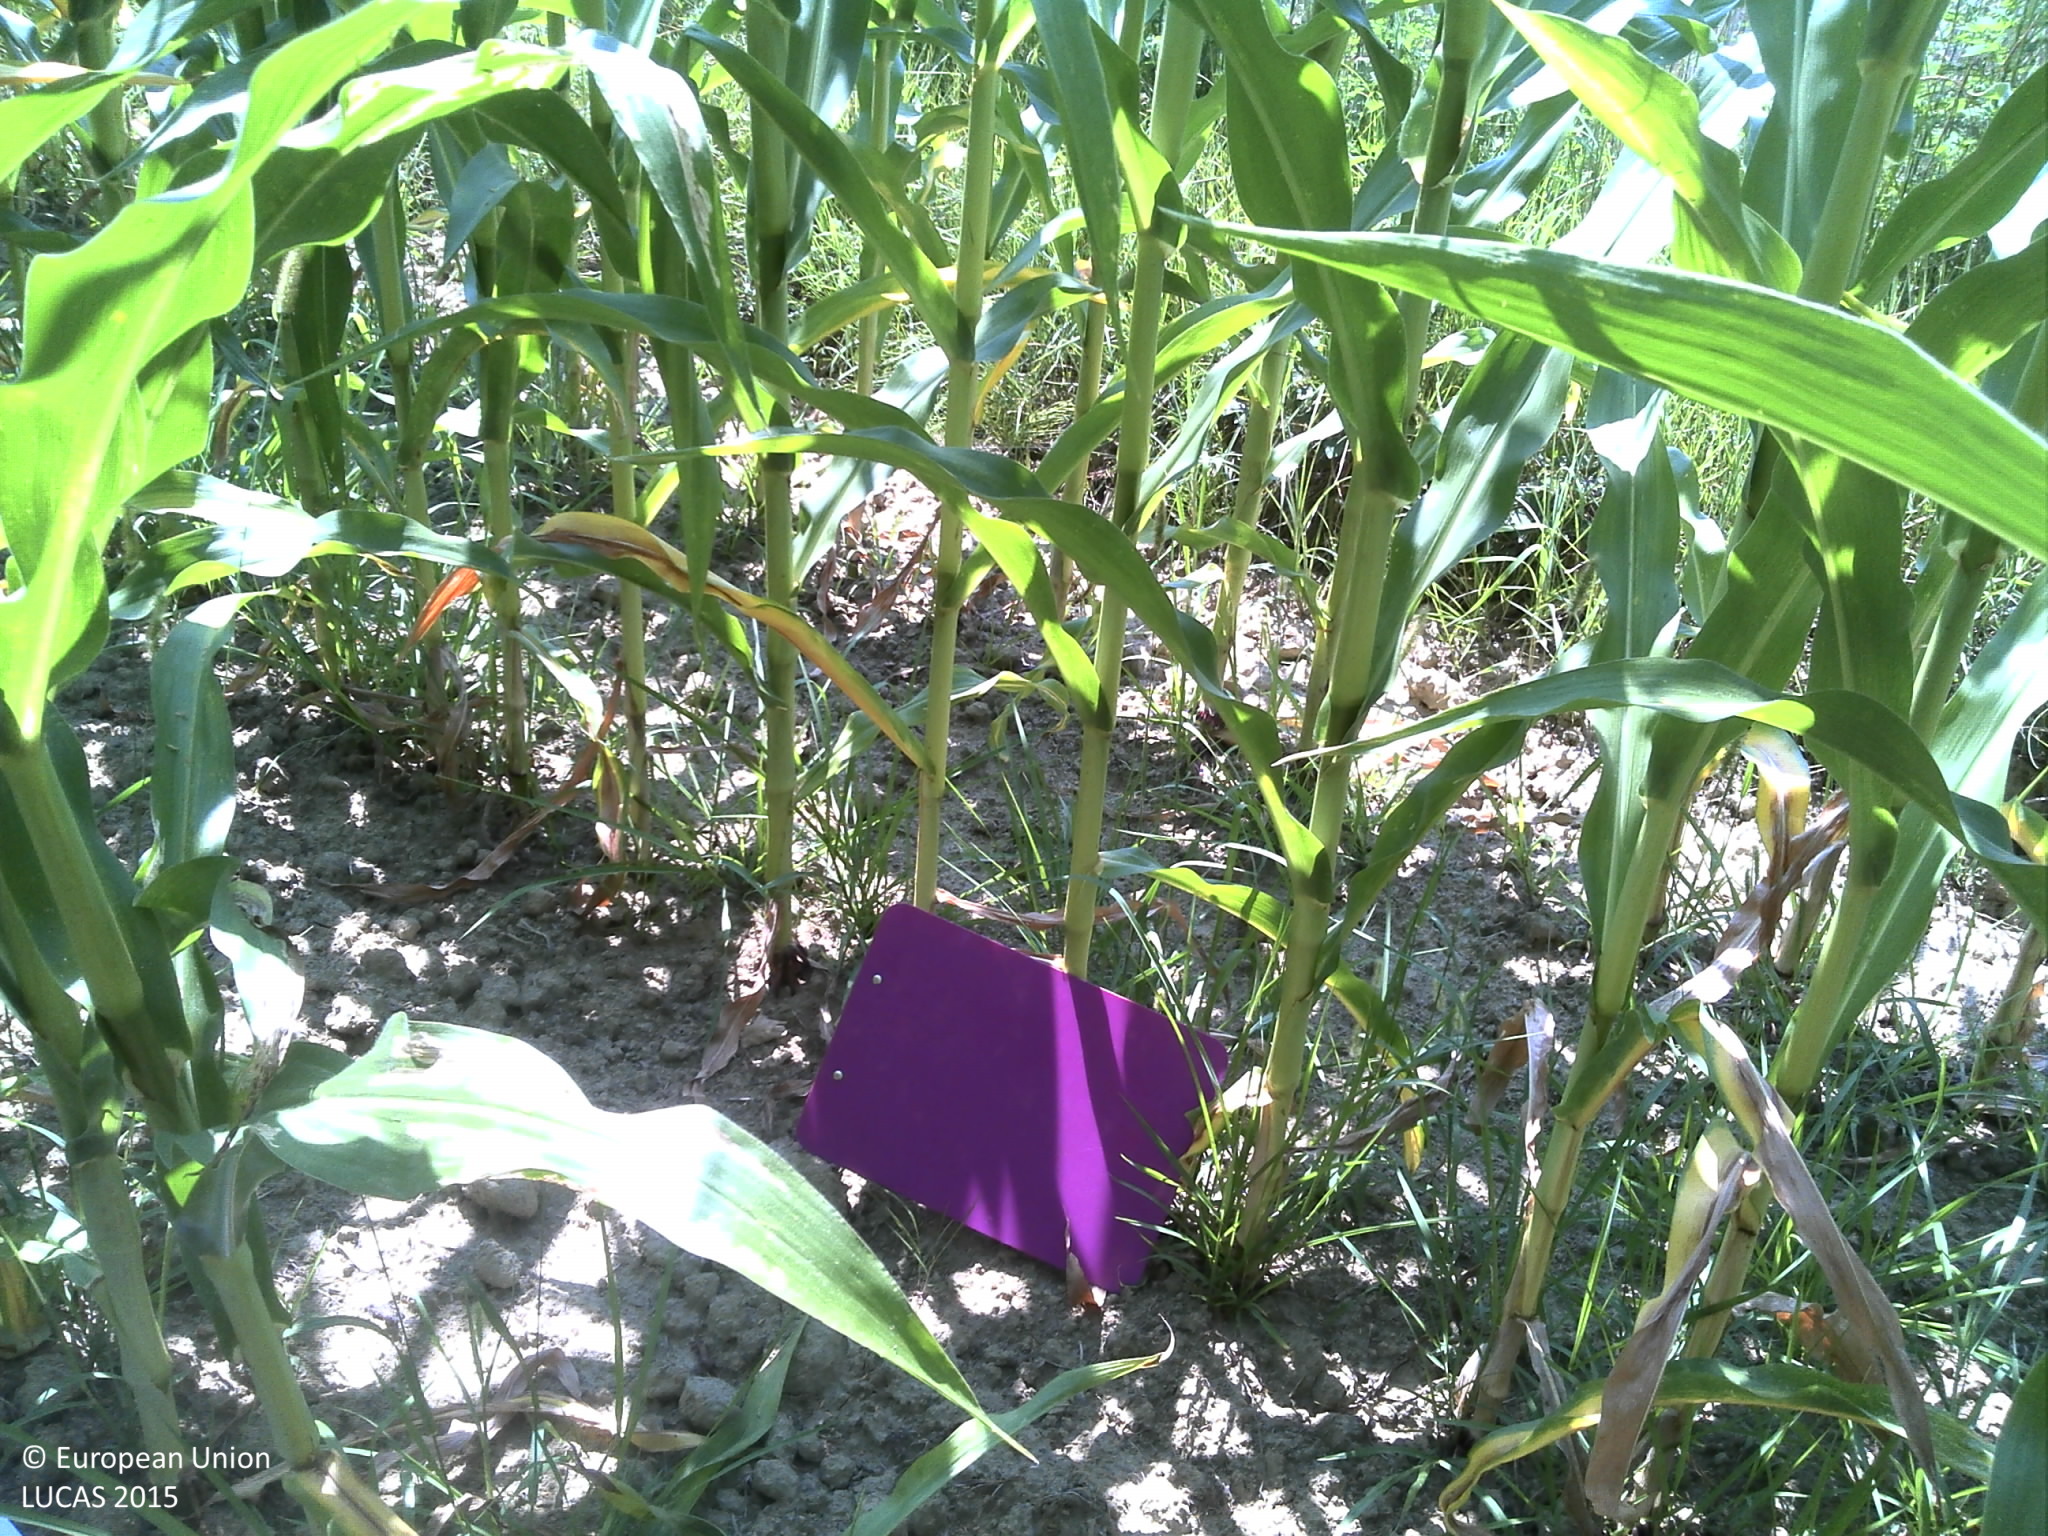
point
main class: Cropland
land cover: Maize
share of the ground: > 75 %
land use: Agriculture (excluding fallow land and kitchen gardens)
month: July
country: HR
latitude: 45.8660
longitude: 16.7628
